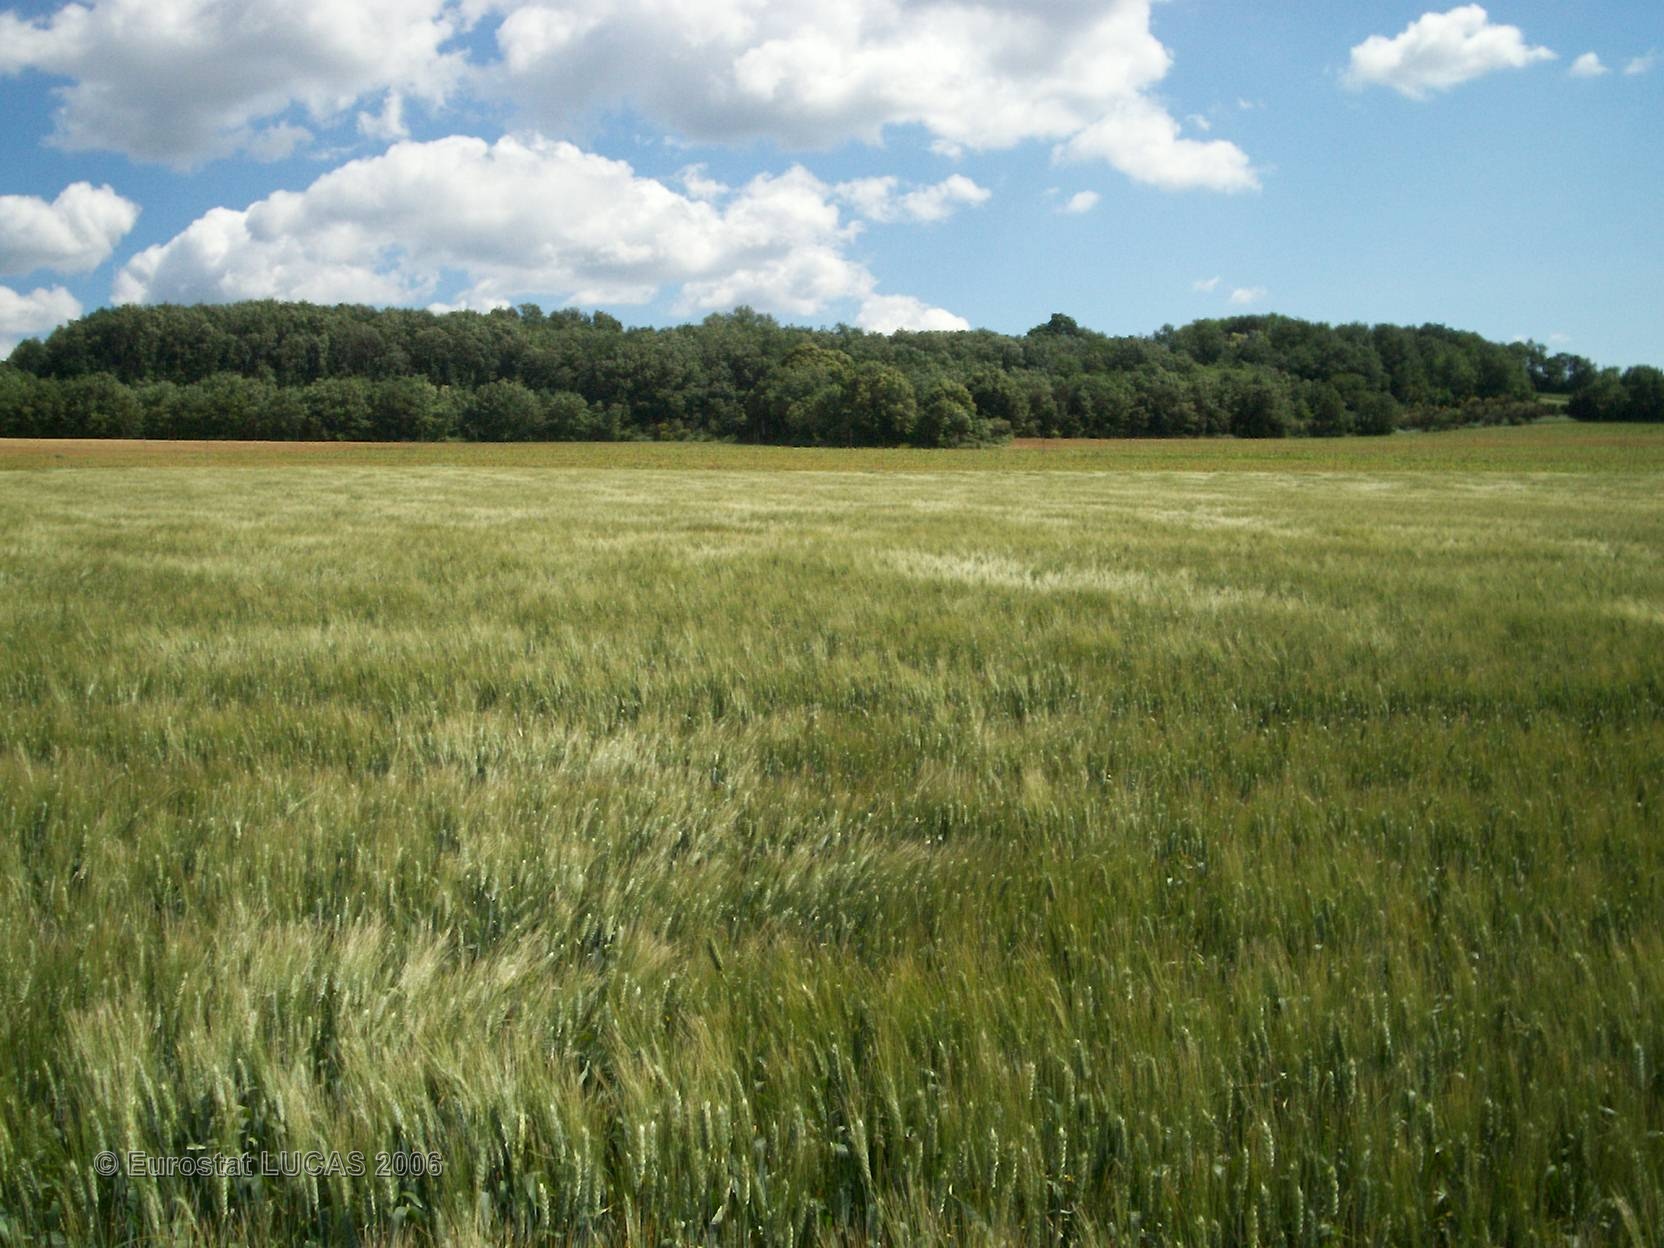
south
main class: Cropland
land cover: Durum wheat
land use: Agriculture (excluding fallow land and kitchen gardens)
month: May
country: FR
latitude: 44.5651
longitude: 4.8318
